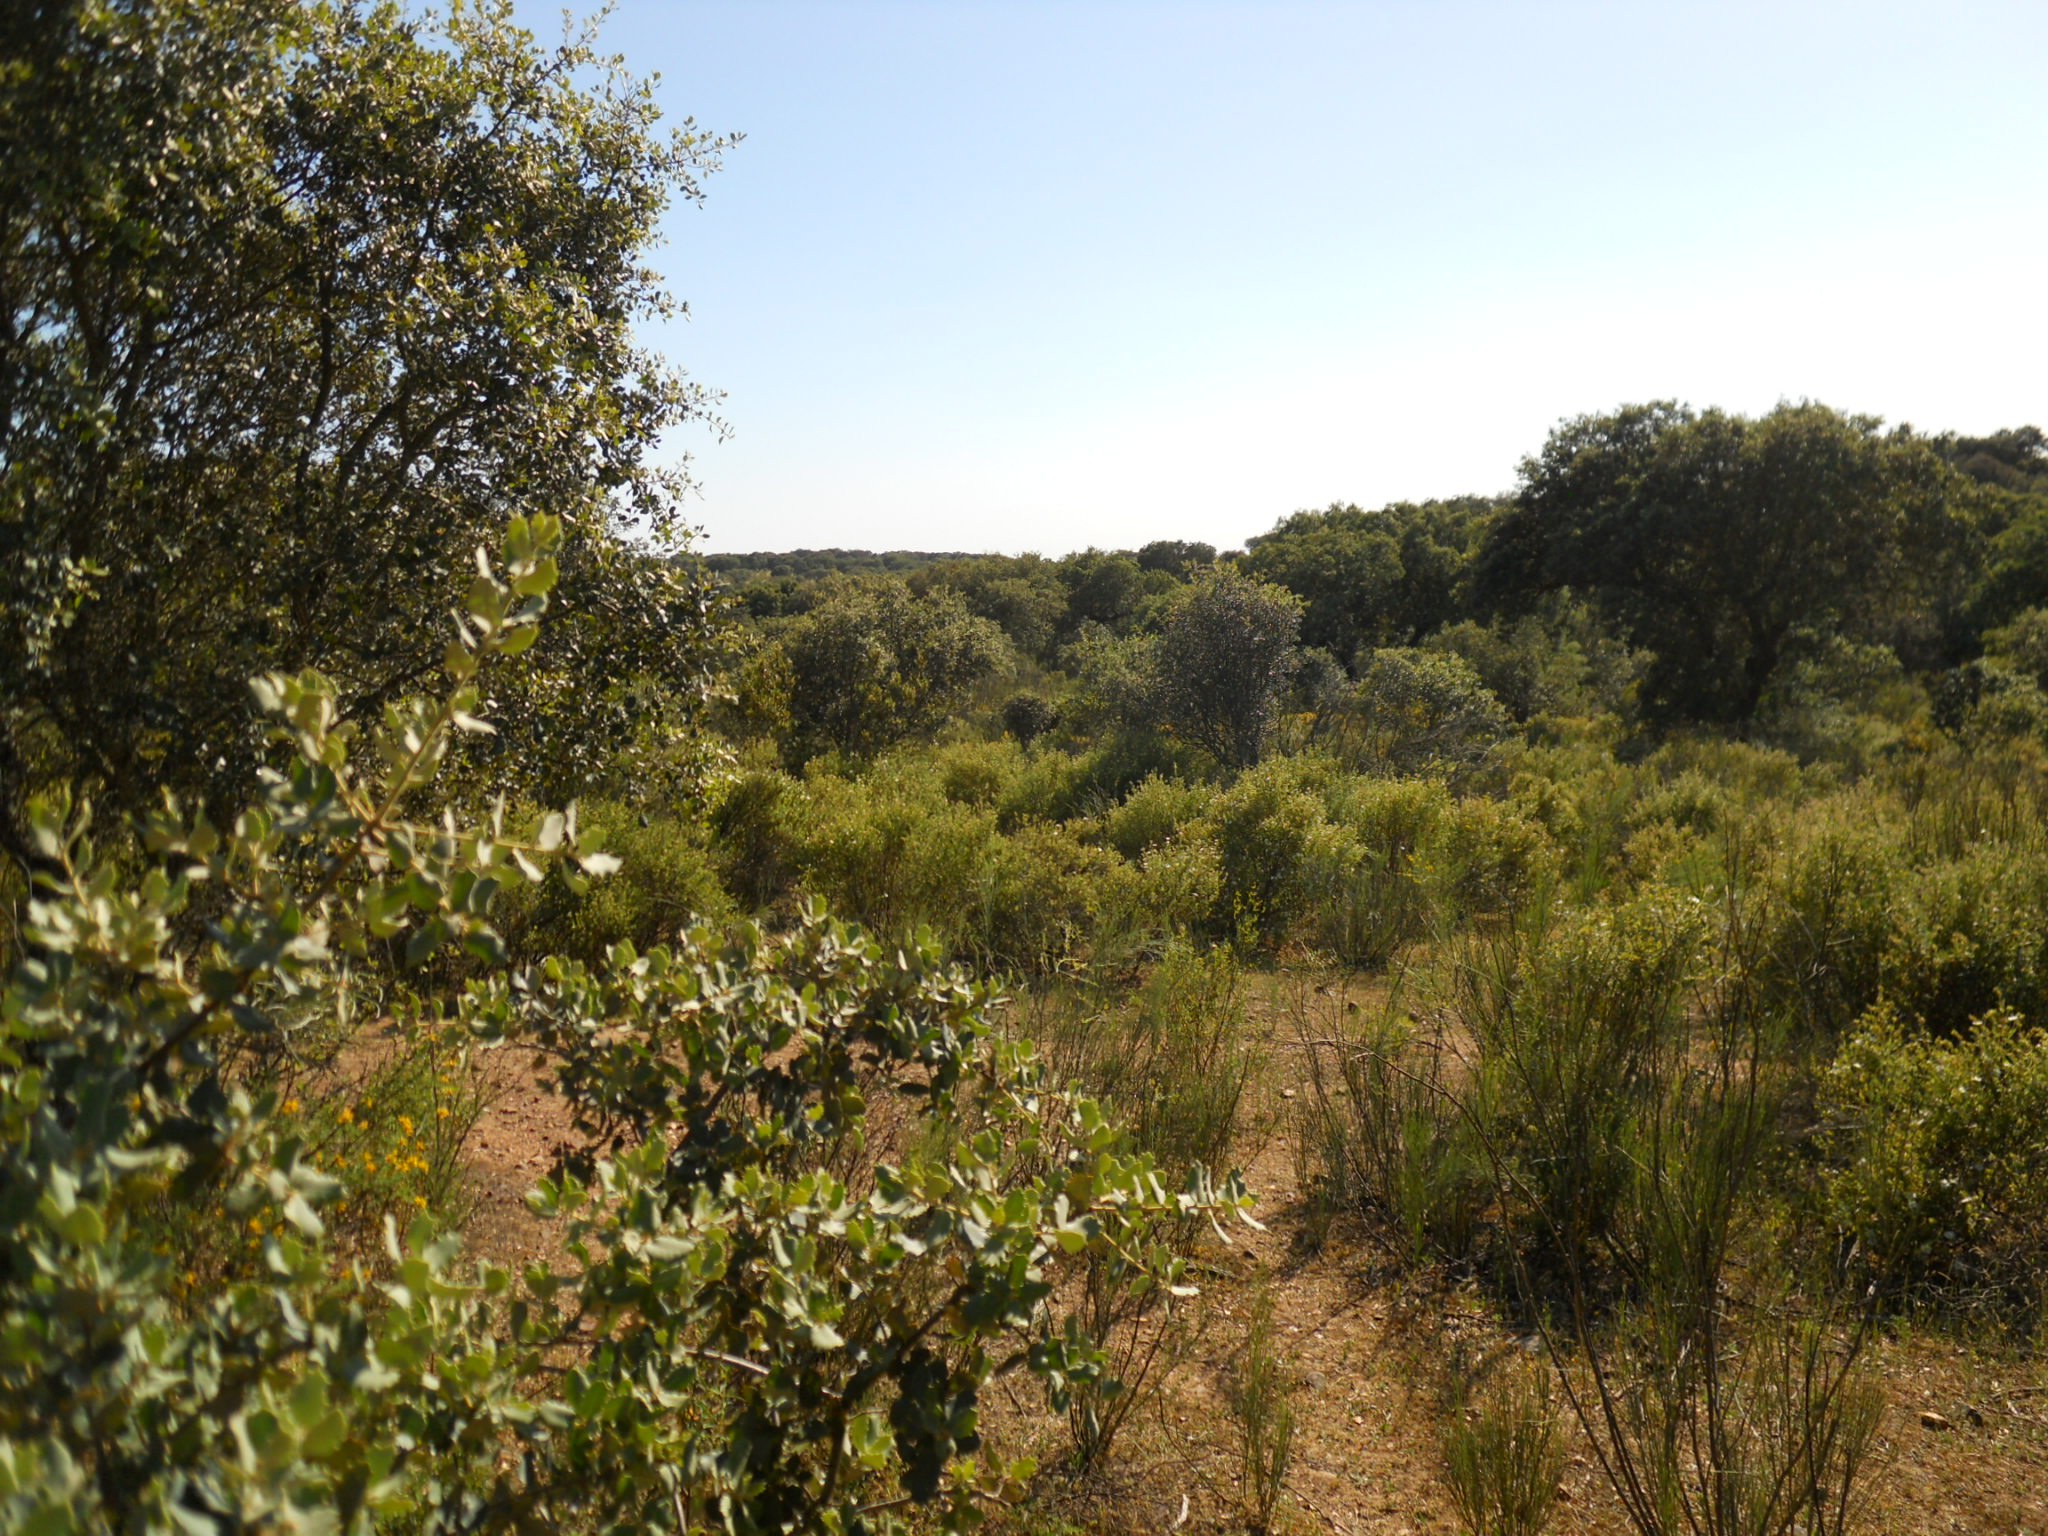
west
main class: Woodland
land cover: Broadleaved woodland
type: broadleaved evergreen forest
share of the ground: > 75 %
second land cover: Shrubland without tree cover
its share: > 75 %
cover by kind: broadleaved forest trees 80 %, shrubs 15 %, herbaceous plants 5 %
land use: Forestry
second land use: Agriculture (excluding fallow land and kitchen gardens)
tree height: > 5 m
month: May
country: ES
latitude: 39.0391
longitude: -6.5266
